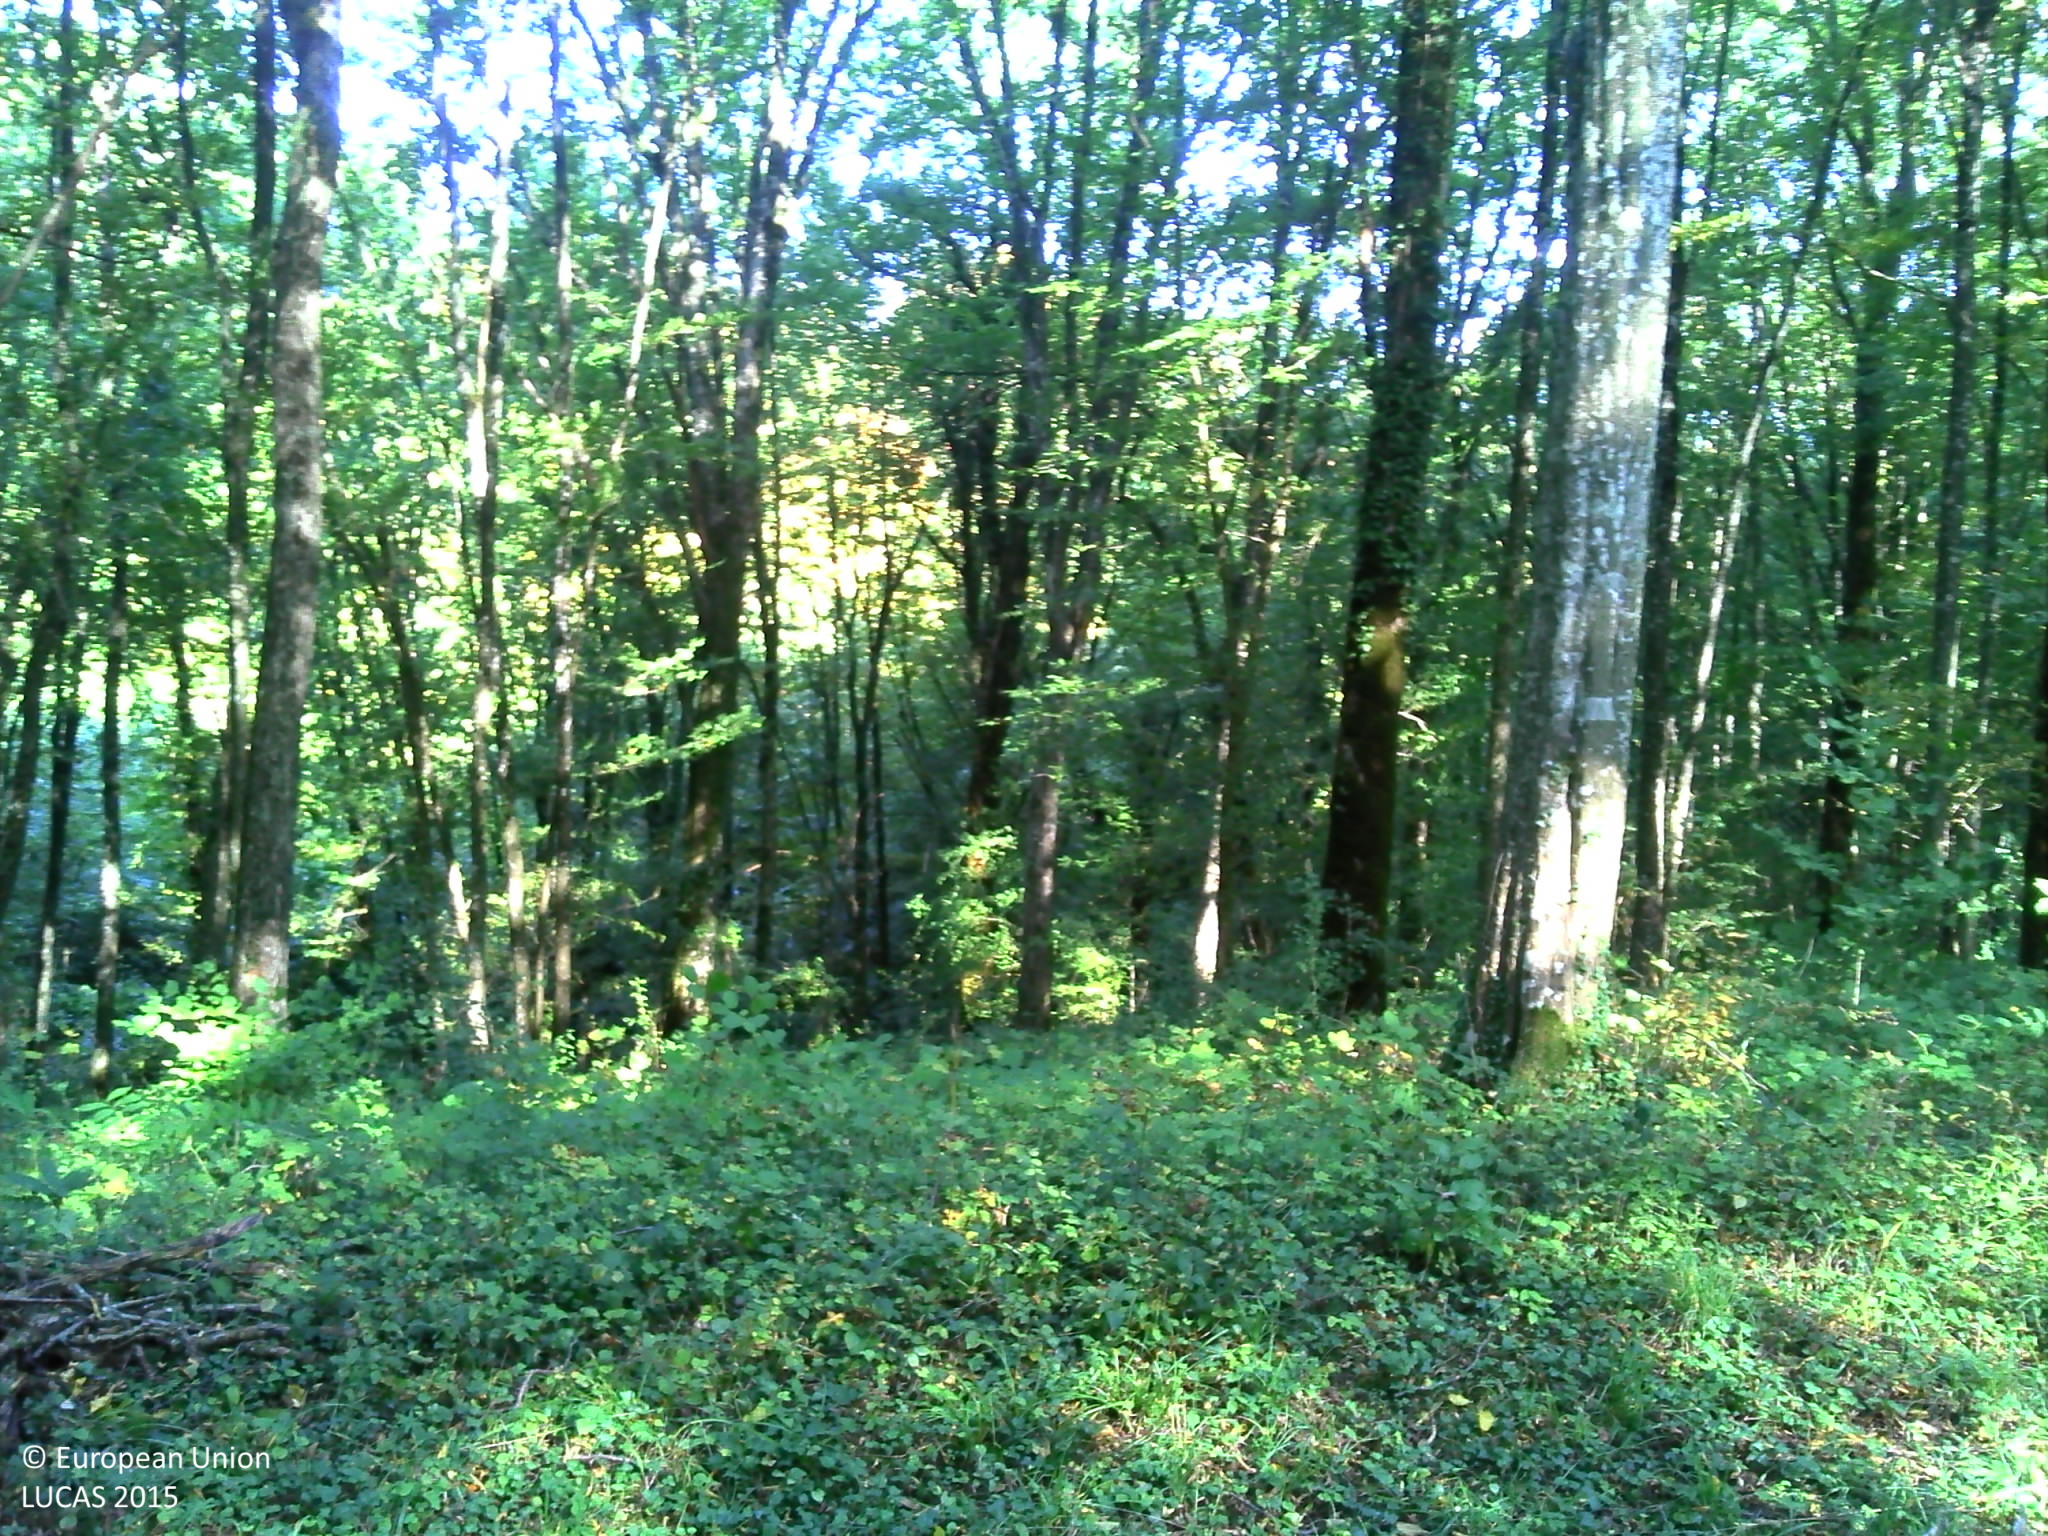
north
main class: Woodland
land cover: Broadleaved woodland
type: mesophytic deciduous forest
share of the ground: > 75 %
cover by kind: broadleaved forest trees 90 %, herbaceous plants 5 %, consolidated bare surface 5 %
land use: Forestry
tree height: > 5 m
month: September
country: FR
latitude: 49.2838
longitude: 5.9439
